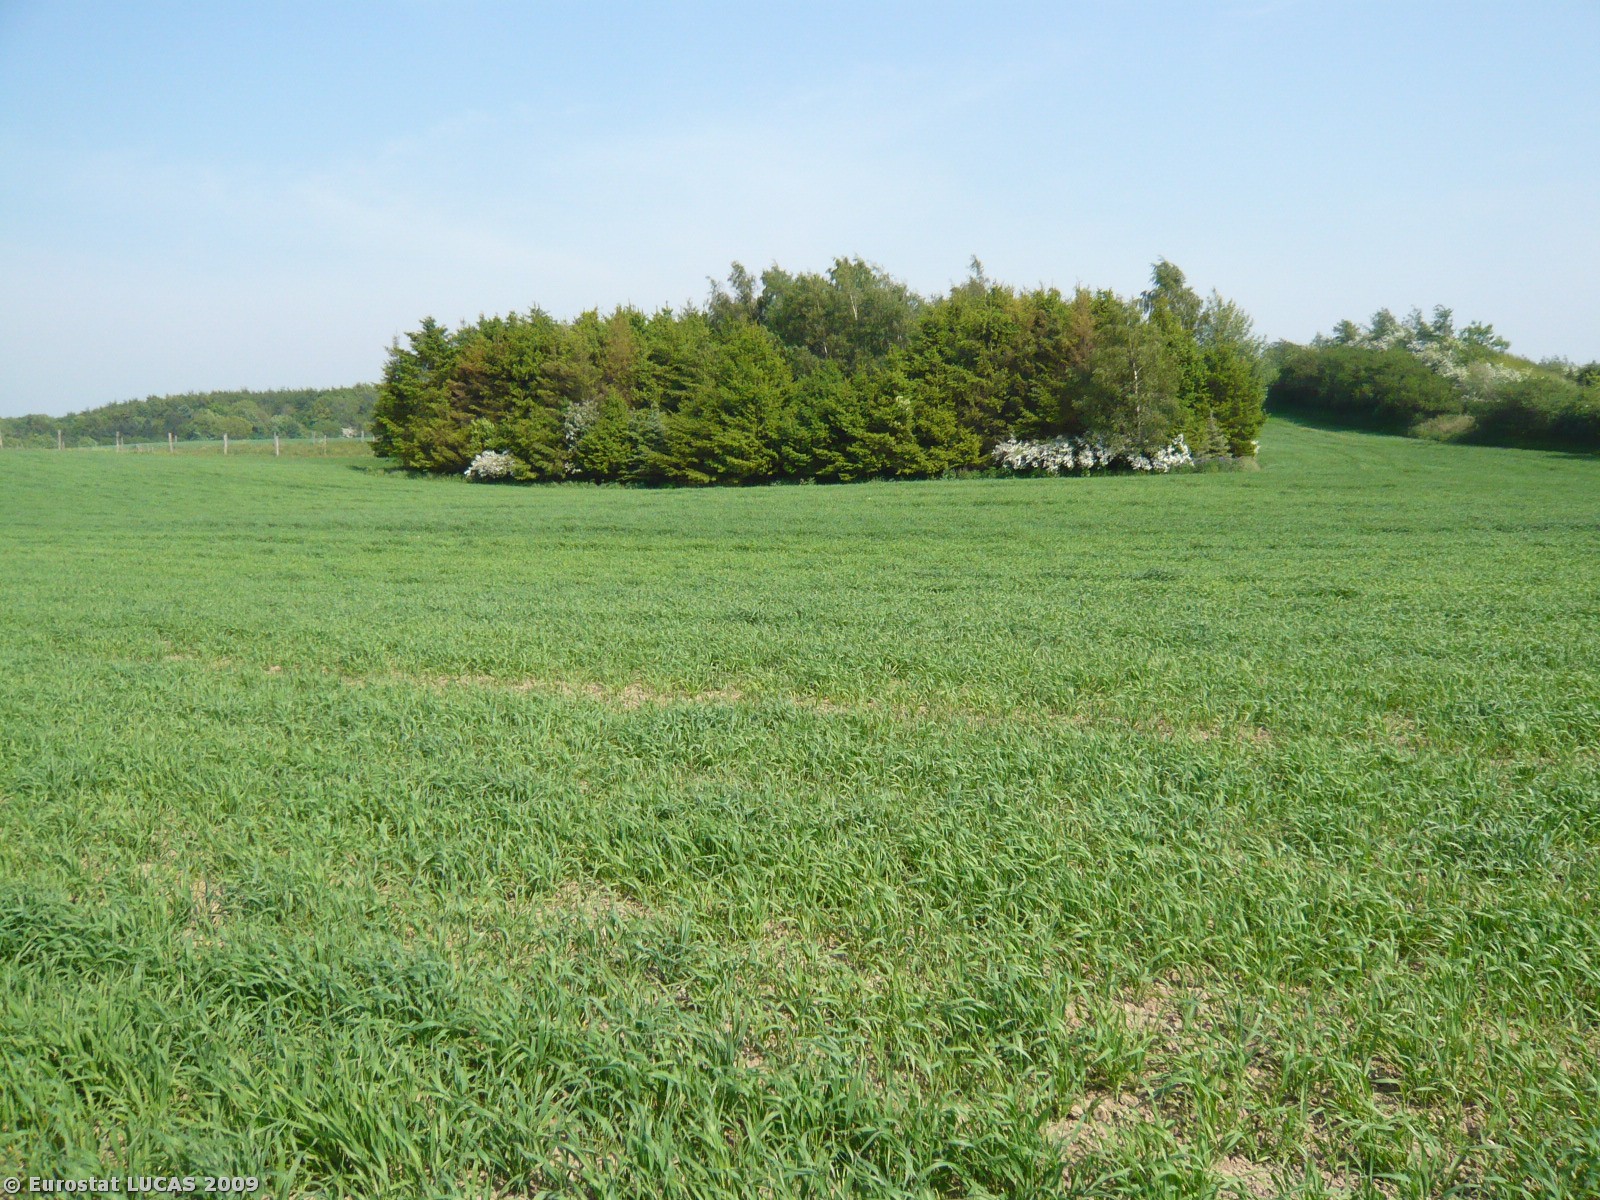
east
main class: Cropland
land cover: Barley
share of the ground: > 75 %
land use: Agriculture (excluding fallow land and kitchen gardens)
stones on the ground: < 10 %
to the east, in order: Barley; Coniferous woodland; Barley; Fences; Shrubland with sparse tree cover; Paved roads, cycling and walking lanes; Grass margins; Common wheat
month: May
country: DK
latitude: 55.2414
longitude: 11.7130
